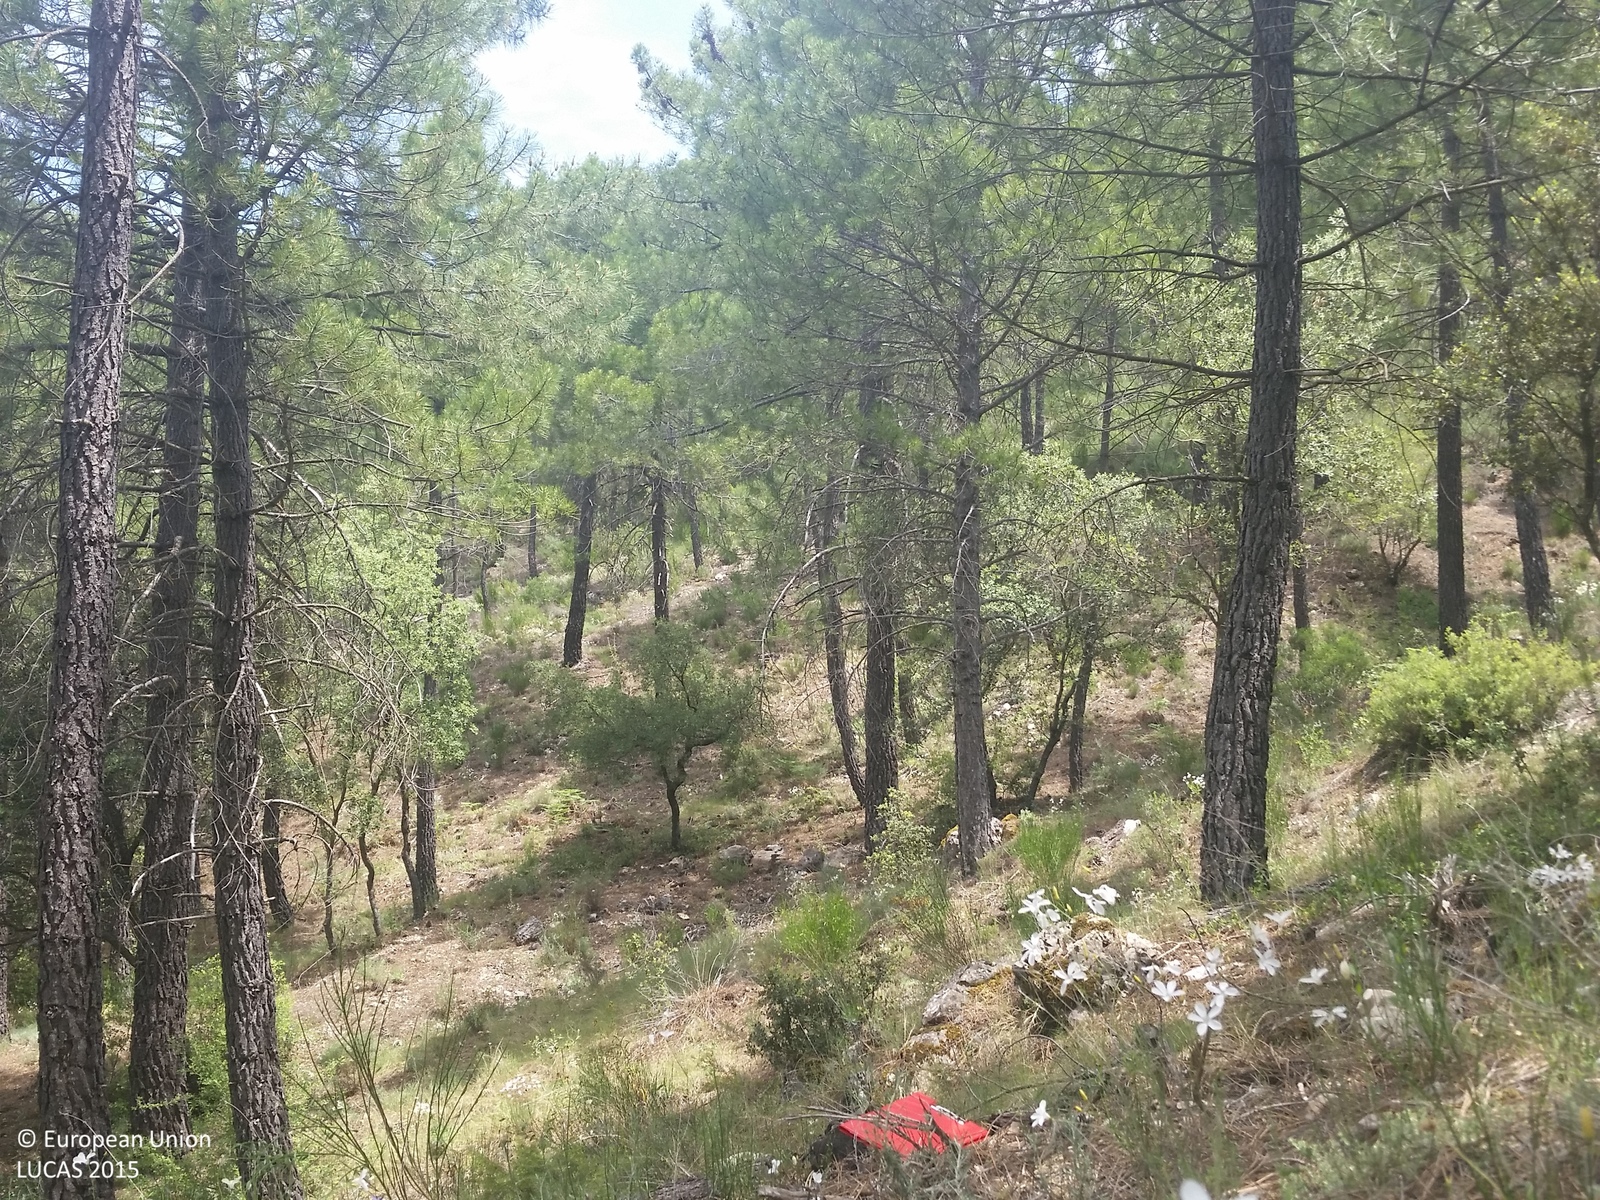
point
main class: Woodland
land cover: Pine dominated coniferous woodland
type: coniferous forest of the mediterranean region
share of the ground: > 75 %
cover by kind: coniferous forest trees 100 %
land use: Forestry
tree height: > 5 m
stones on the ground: 10 - 25 %
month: June
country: ES
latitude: 38.5204
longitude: -2.4434
